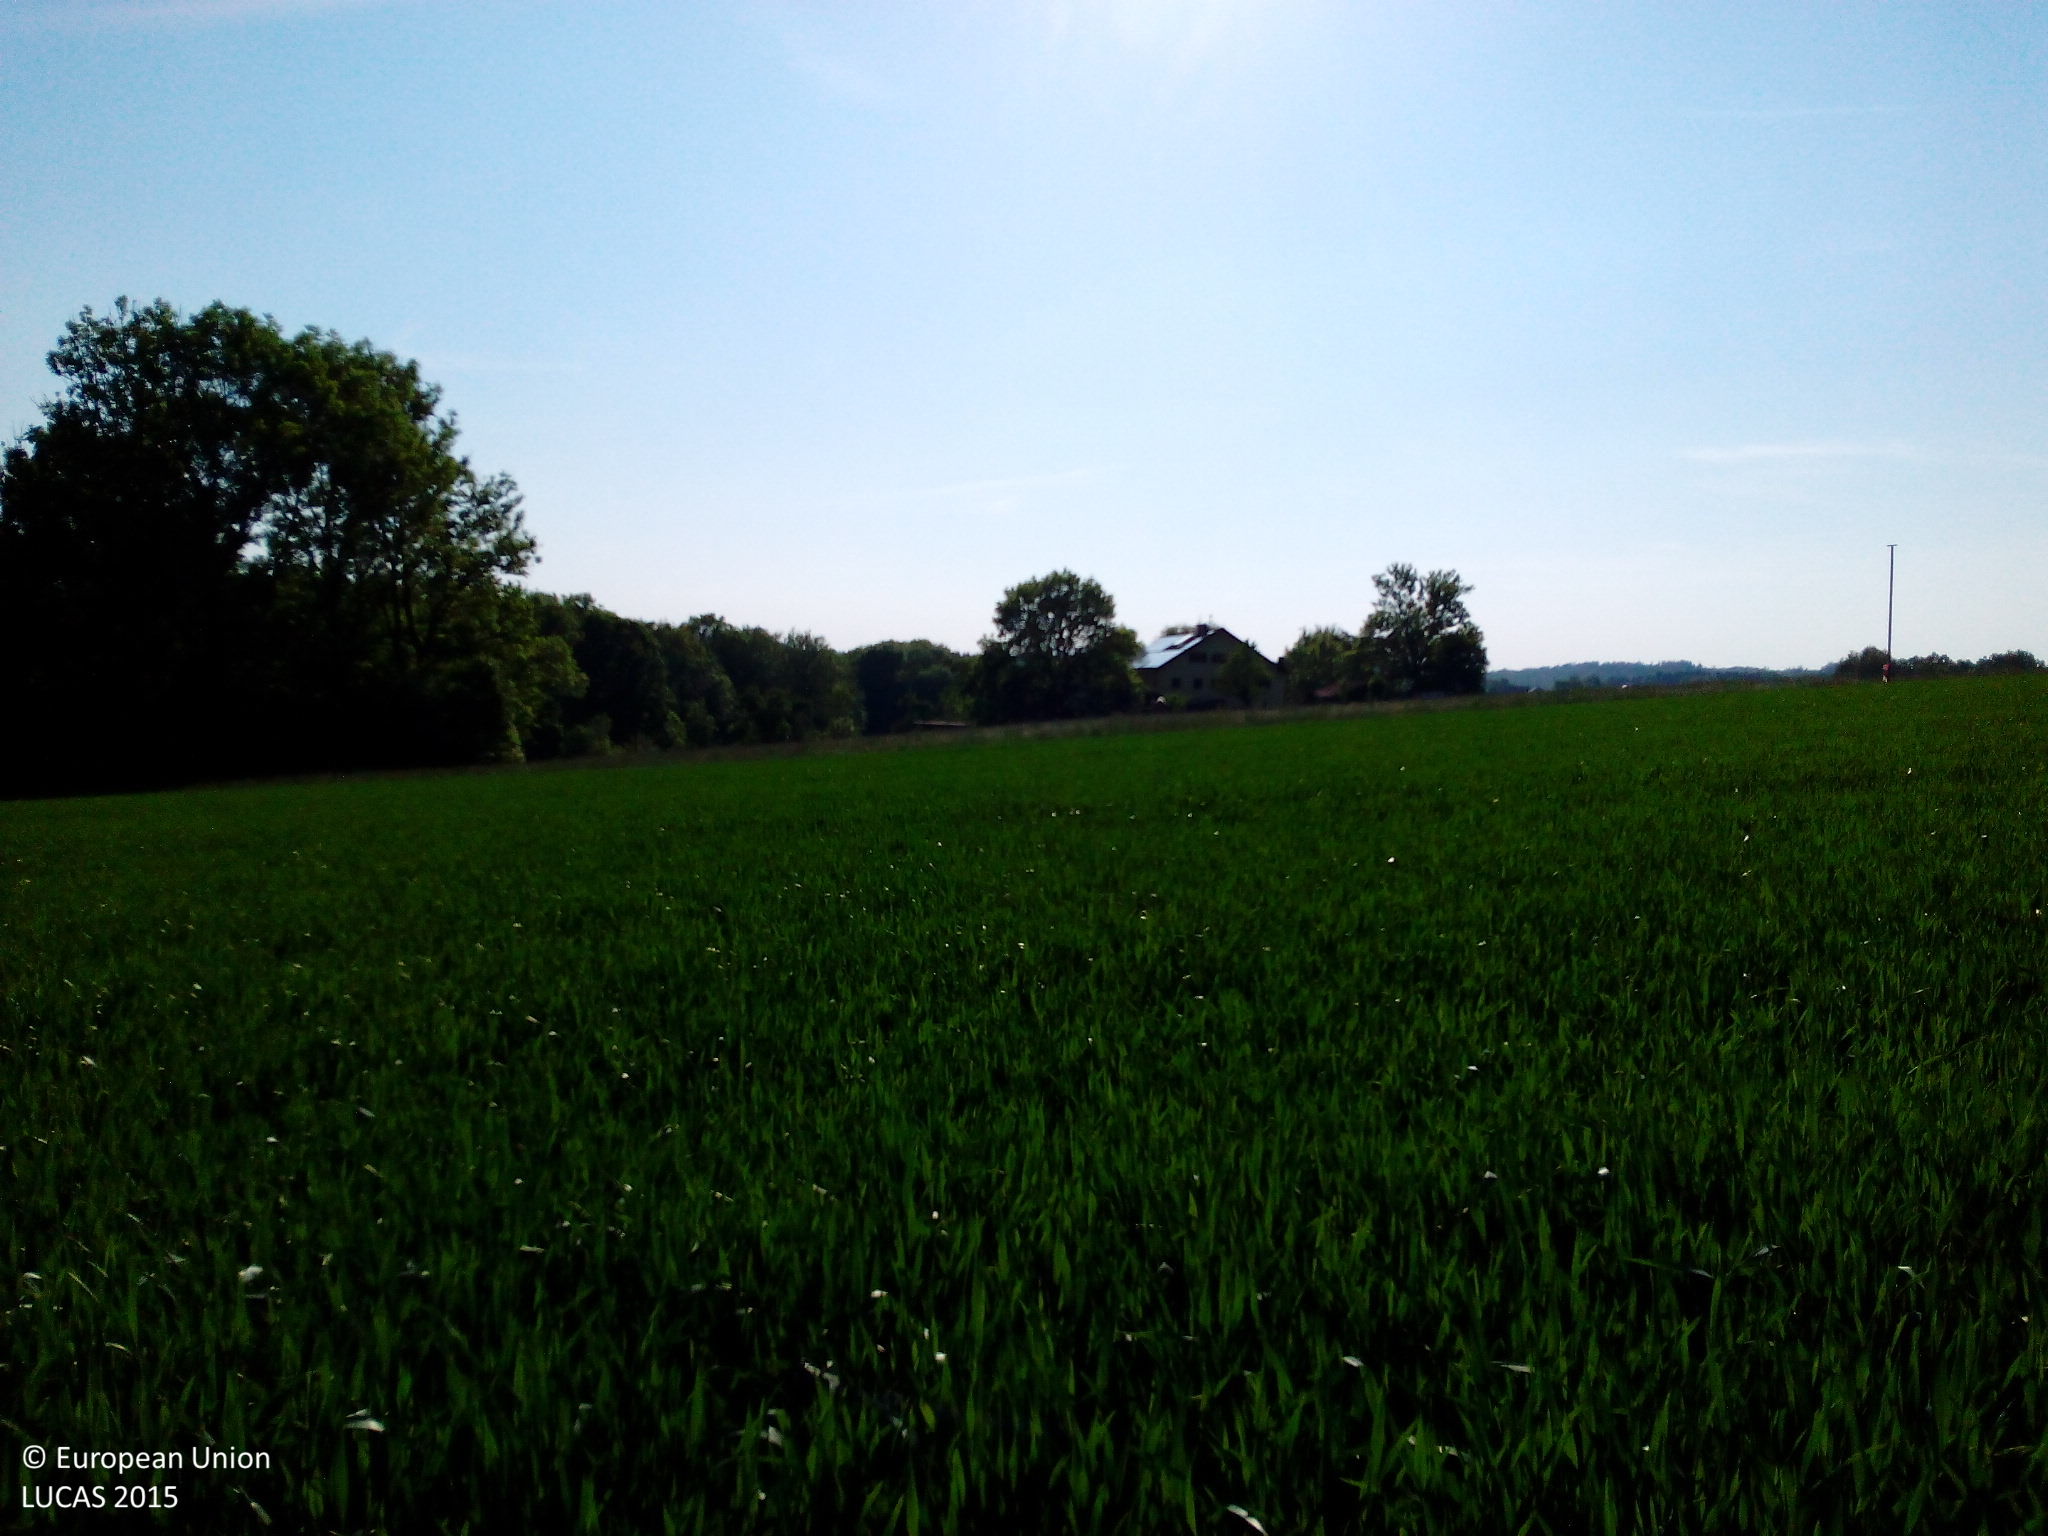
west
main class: Cropland
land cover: Common wheat
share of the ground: > 75 %
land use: Agriculture (excluding fallow land and kitchen gardens)
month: May
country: DE
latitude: 48.2213
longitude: 12.1122
